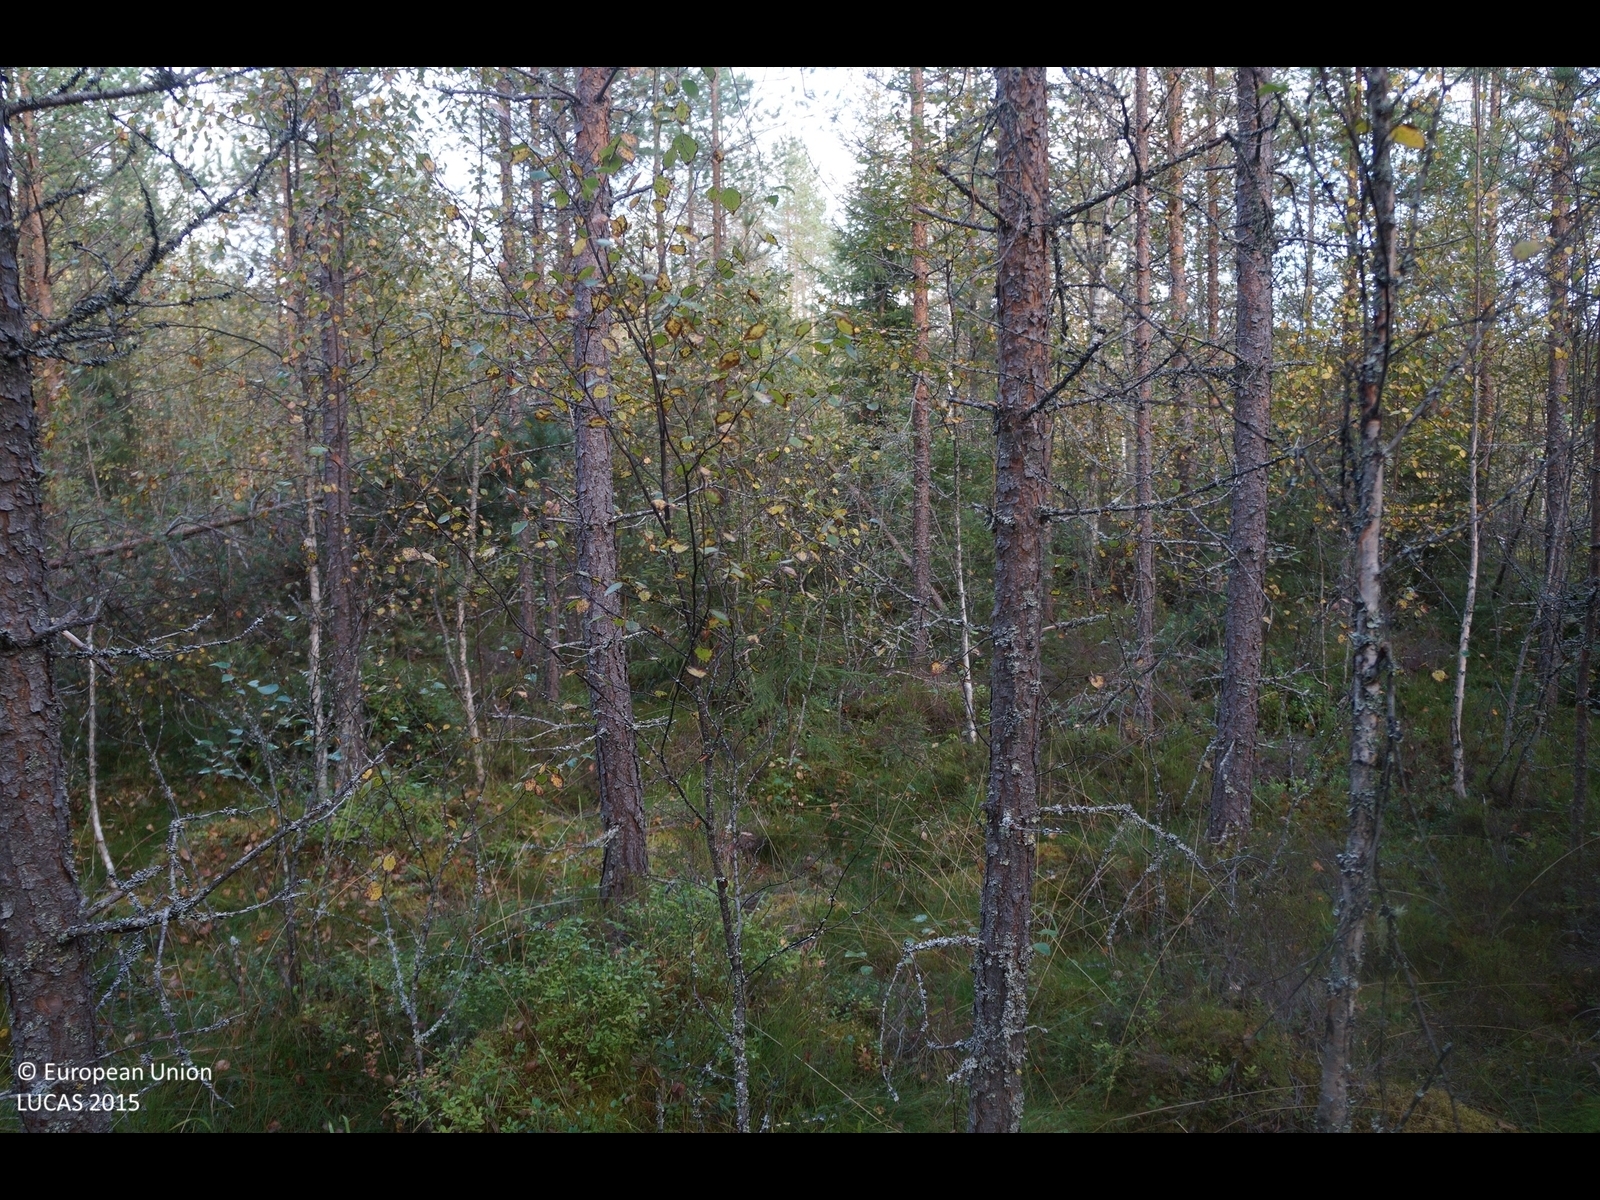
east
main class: Woodland
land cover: Pine dominated coniferous woodland
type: boreal forest
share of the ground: 50 - 75 %
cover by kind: coniferous forest trees 70 %, shrubs 20 %, herbaceous plants 5 %, lichens and mosses 5 %
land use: Forestry
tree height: > 5 m
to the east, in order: Pine dominated coniferous woodland; Other mixed woodland; Ditches and canals; Other mixed woodland; Ditches and canals; Shrubland with sparse tree cover; Other mixed woodland; Pine dominated mixed woodland; Other mixed woodland; Rivers and streams; Other mixed woodland
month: September
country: FI
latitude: 63.8786
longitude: 24.2606
